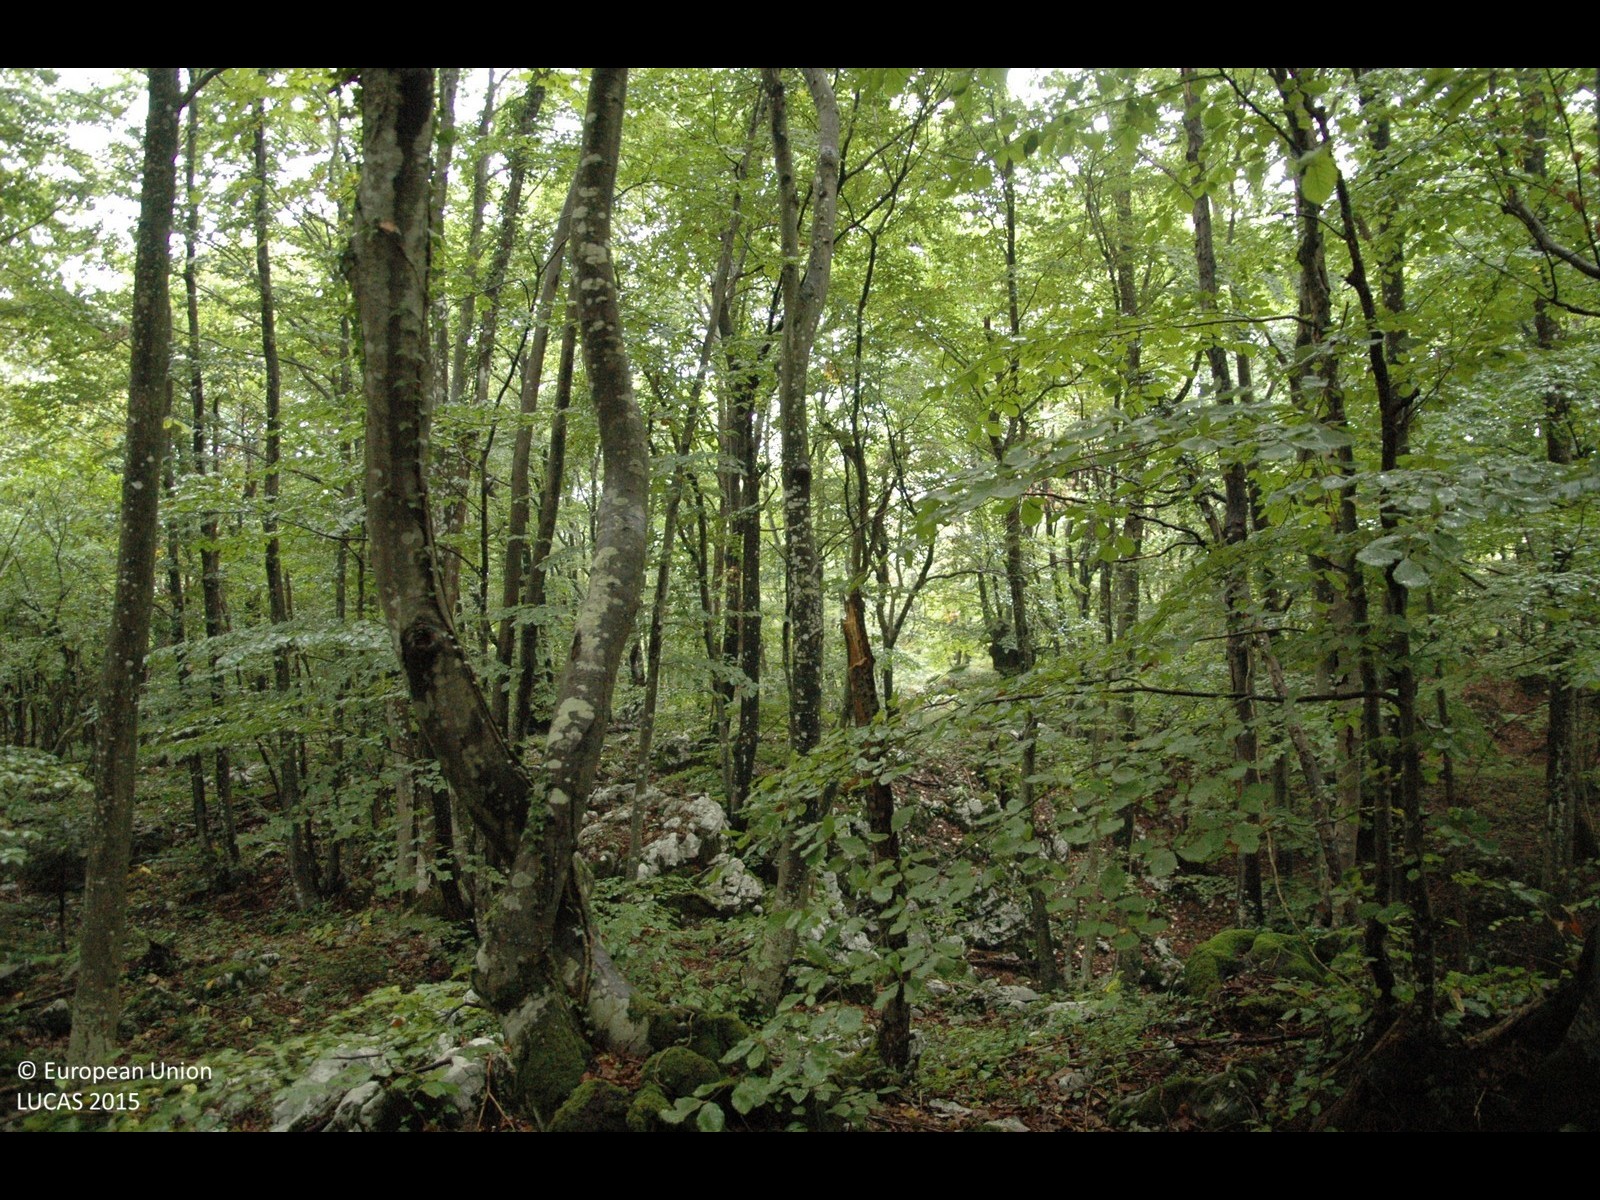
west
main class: Woodland
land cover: Broadleaved woodland
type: beech forest
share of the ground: > 75 %
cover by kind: broadleaved forest trees 100 %
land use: Forestry
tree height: > 5 m
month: October
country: HR
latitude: 45.1392
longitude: 15.2469
